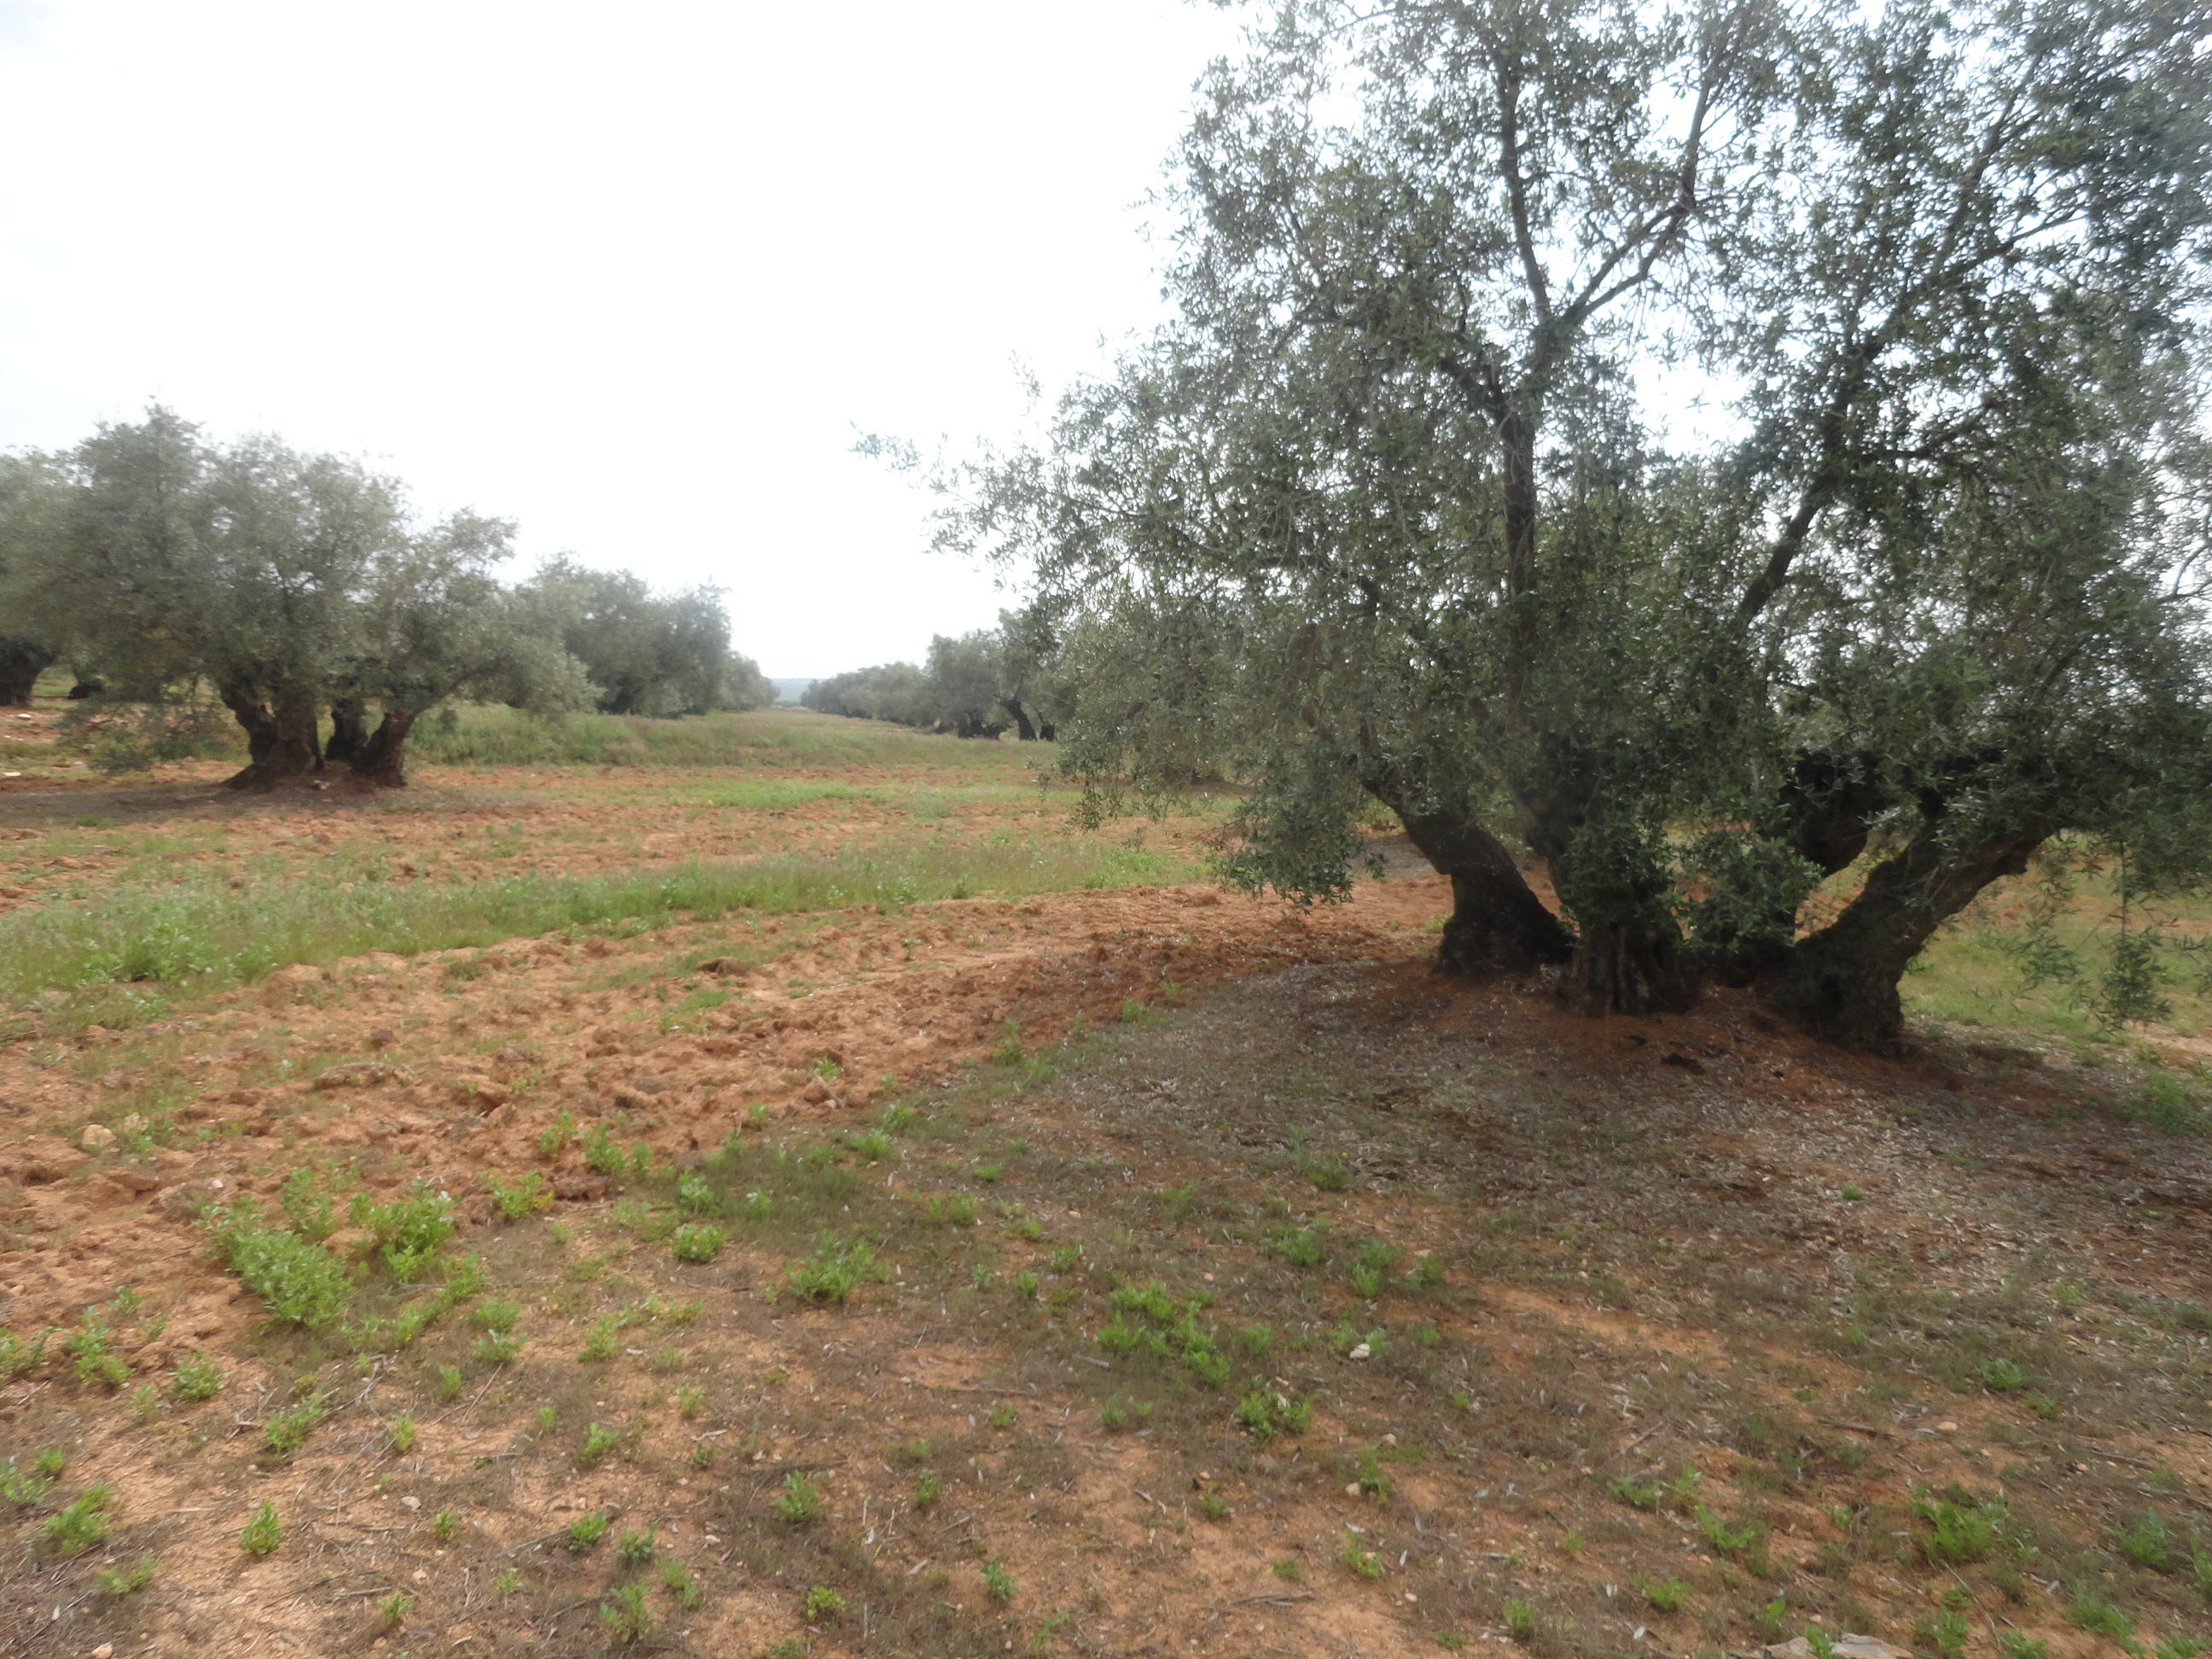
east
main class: Cropland
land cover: Olive groves
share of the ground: 25 - 50 %
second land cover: Spontaneously vegetated surfaces
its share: 50 - 75 %
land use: Agriculture (excluding fallow land and kitchen gardens)
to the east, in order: Olive groves; Spontaneously vegetated surfaces; Tracks; Olive groves
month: April
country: ES
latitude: 37.5204
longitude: -4.5674
